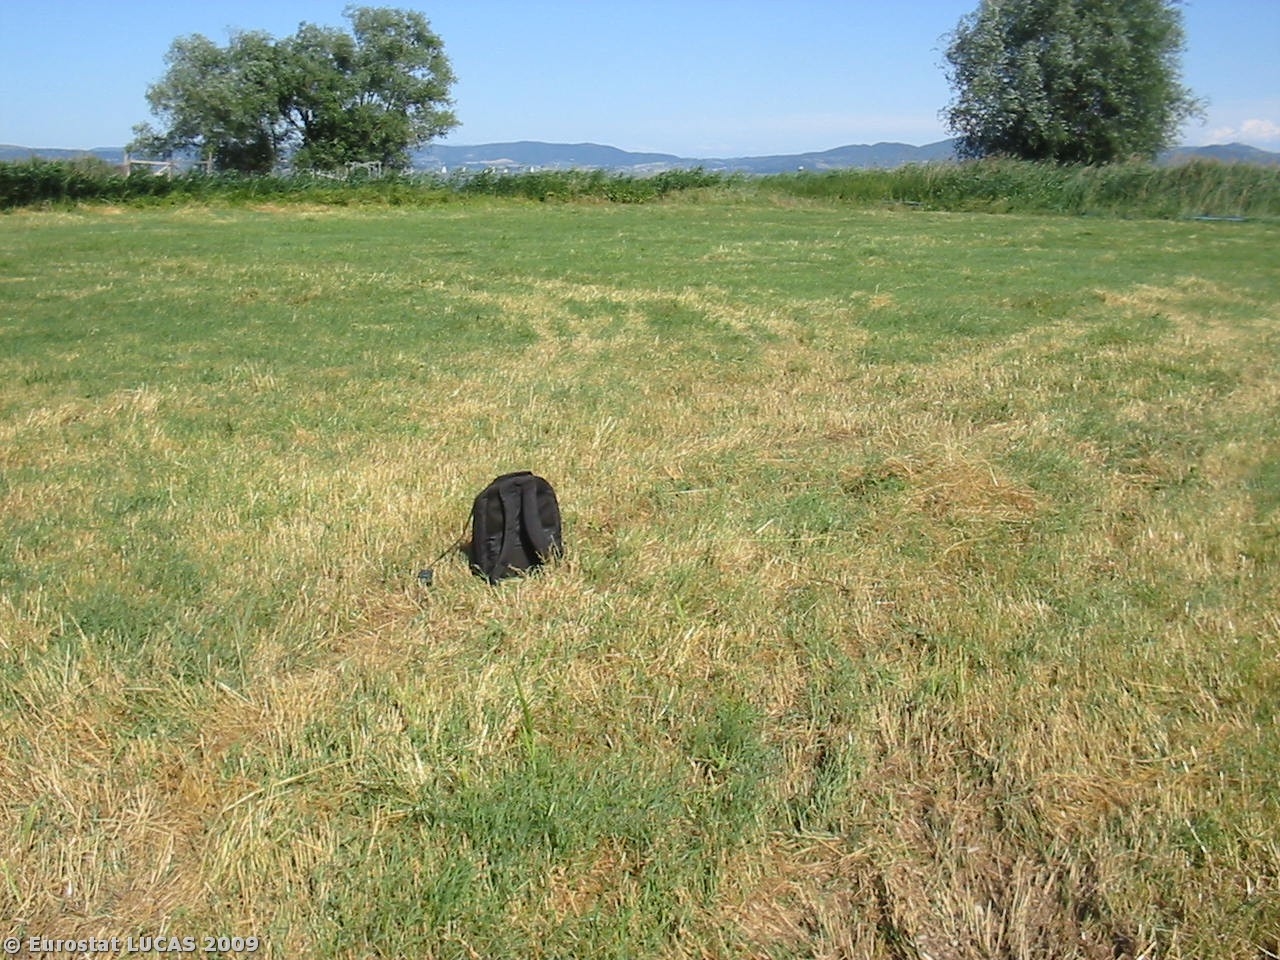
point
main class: Grassland
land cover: Grassland without tree/shrub cover
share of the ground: > 75 %
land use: Agriculture (excluding fallow land and kitchen gardens)
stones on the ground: < 10 %
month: May
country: IT
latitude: 43.1210
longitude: 12.0466
